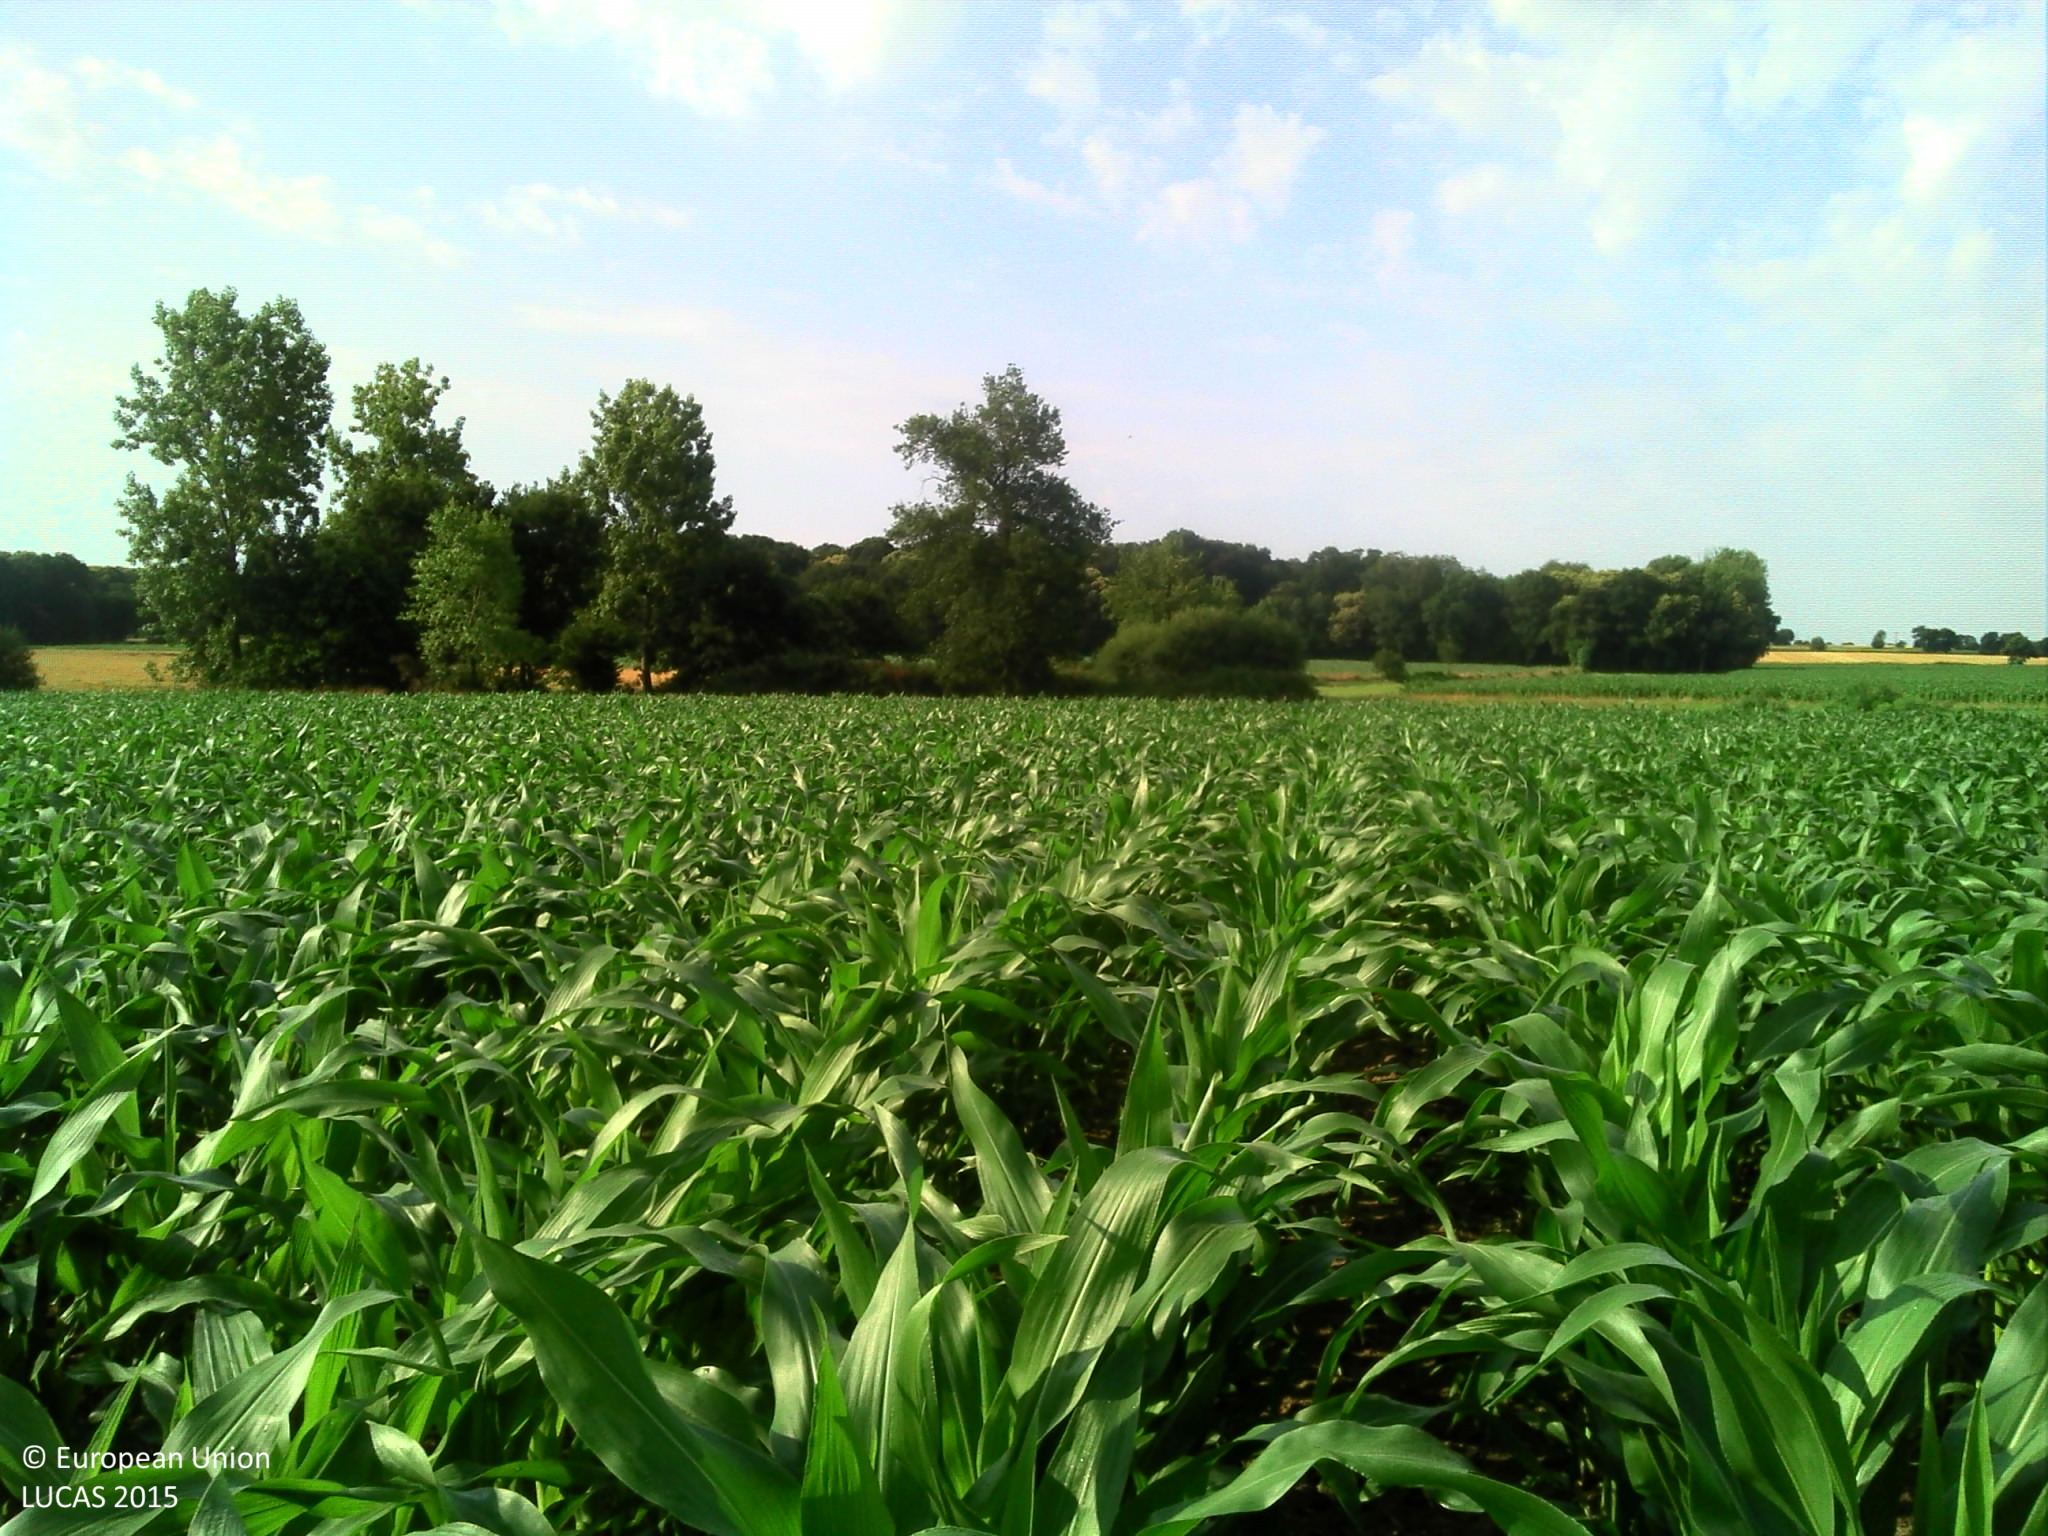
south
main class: Cropland
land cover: Maize
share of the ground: > 75 %
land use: Agriculture (excluding fallow land and kitchen gardens)
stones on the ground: < 10 %
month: July
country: FR
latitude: 48.4144
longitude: -1.5452
